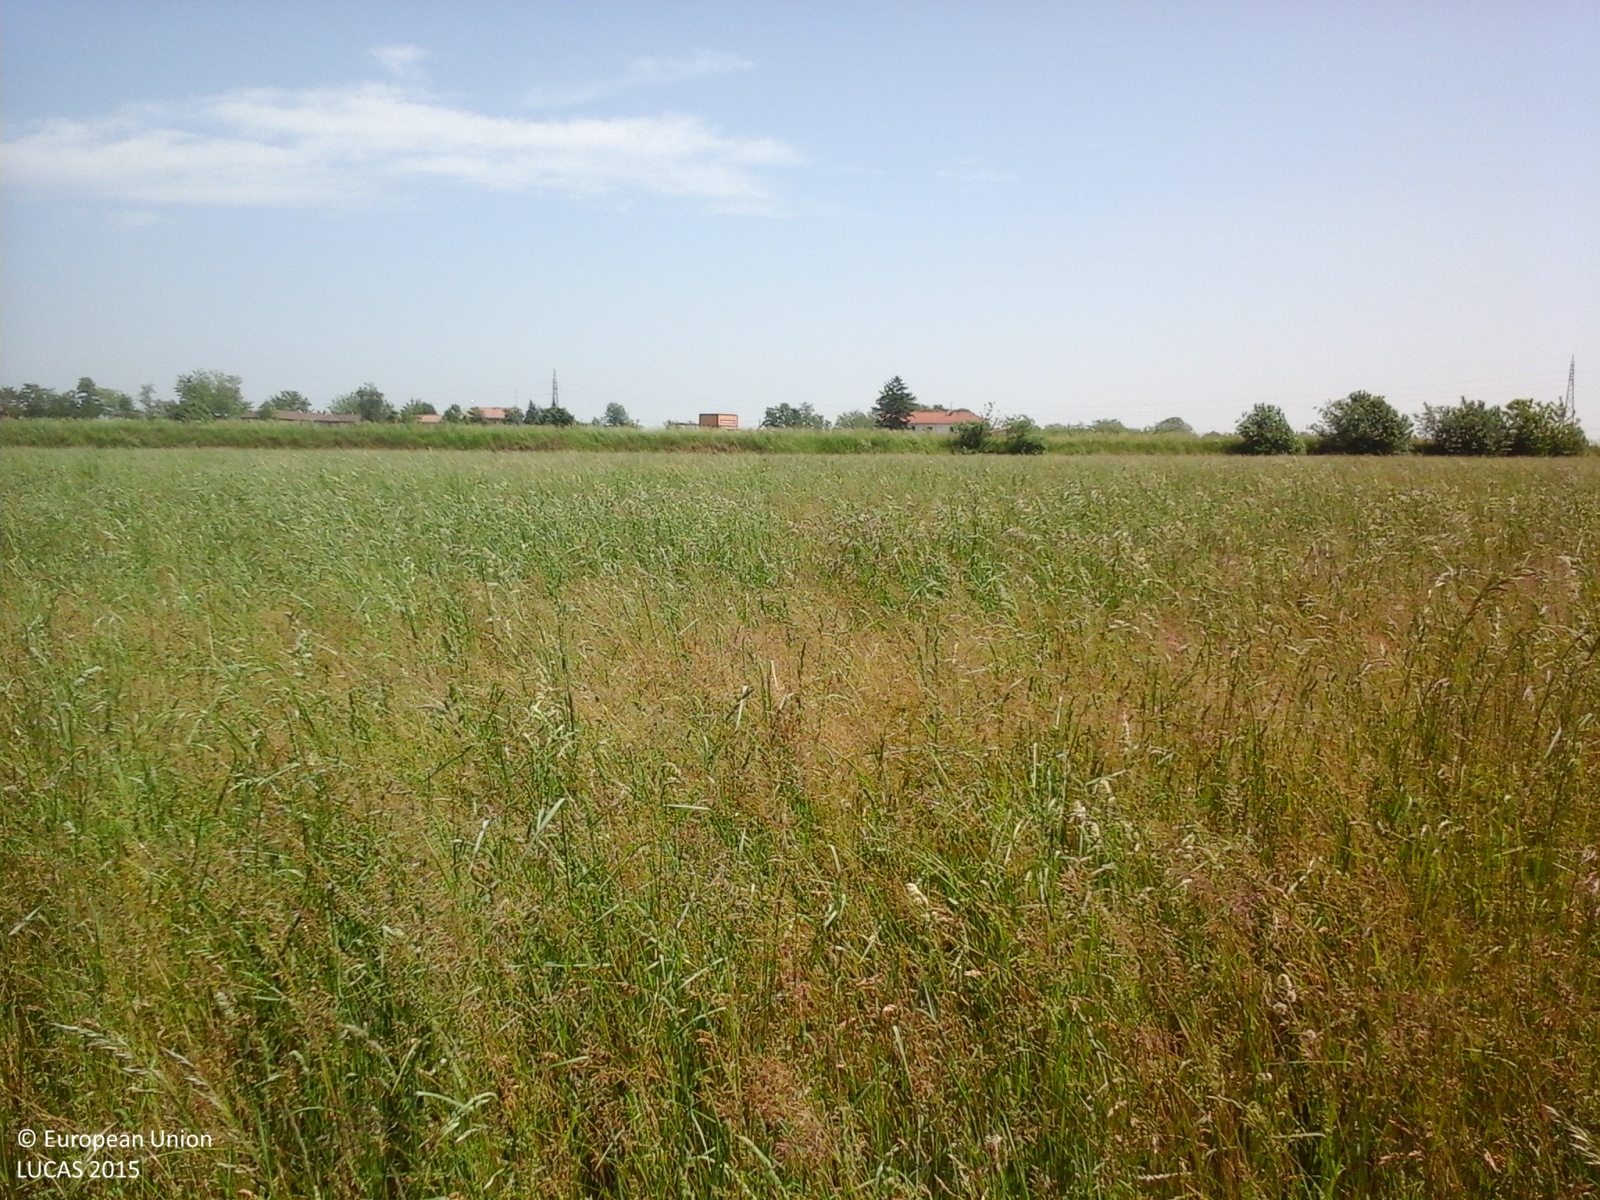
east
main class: Grassland
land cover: Grassland without tree/shrub cover
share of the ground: > 75 %
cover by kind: herbaceous plants 100 %
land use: Agriculture (excluding fallow land and kitchen gardens)
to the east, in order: Grassland without tree/shrub cover; Grass margins; Tracks; Grass margins; Ditches and canals; Grass margins; Other bare soil
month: May
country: IT
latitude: 45.5316
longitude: 8.6321
